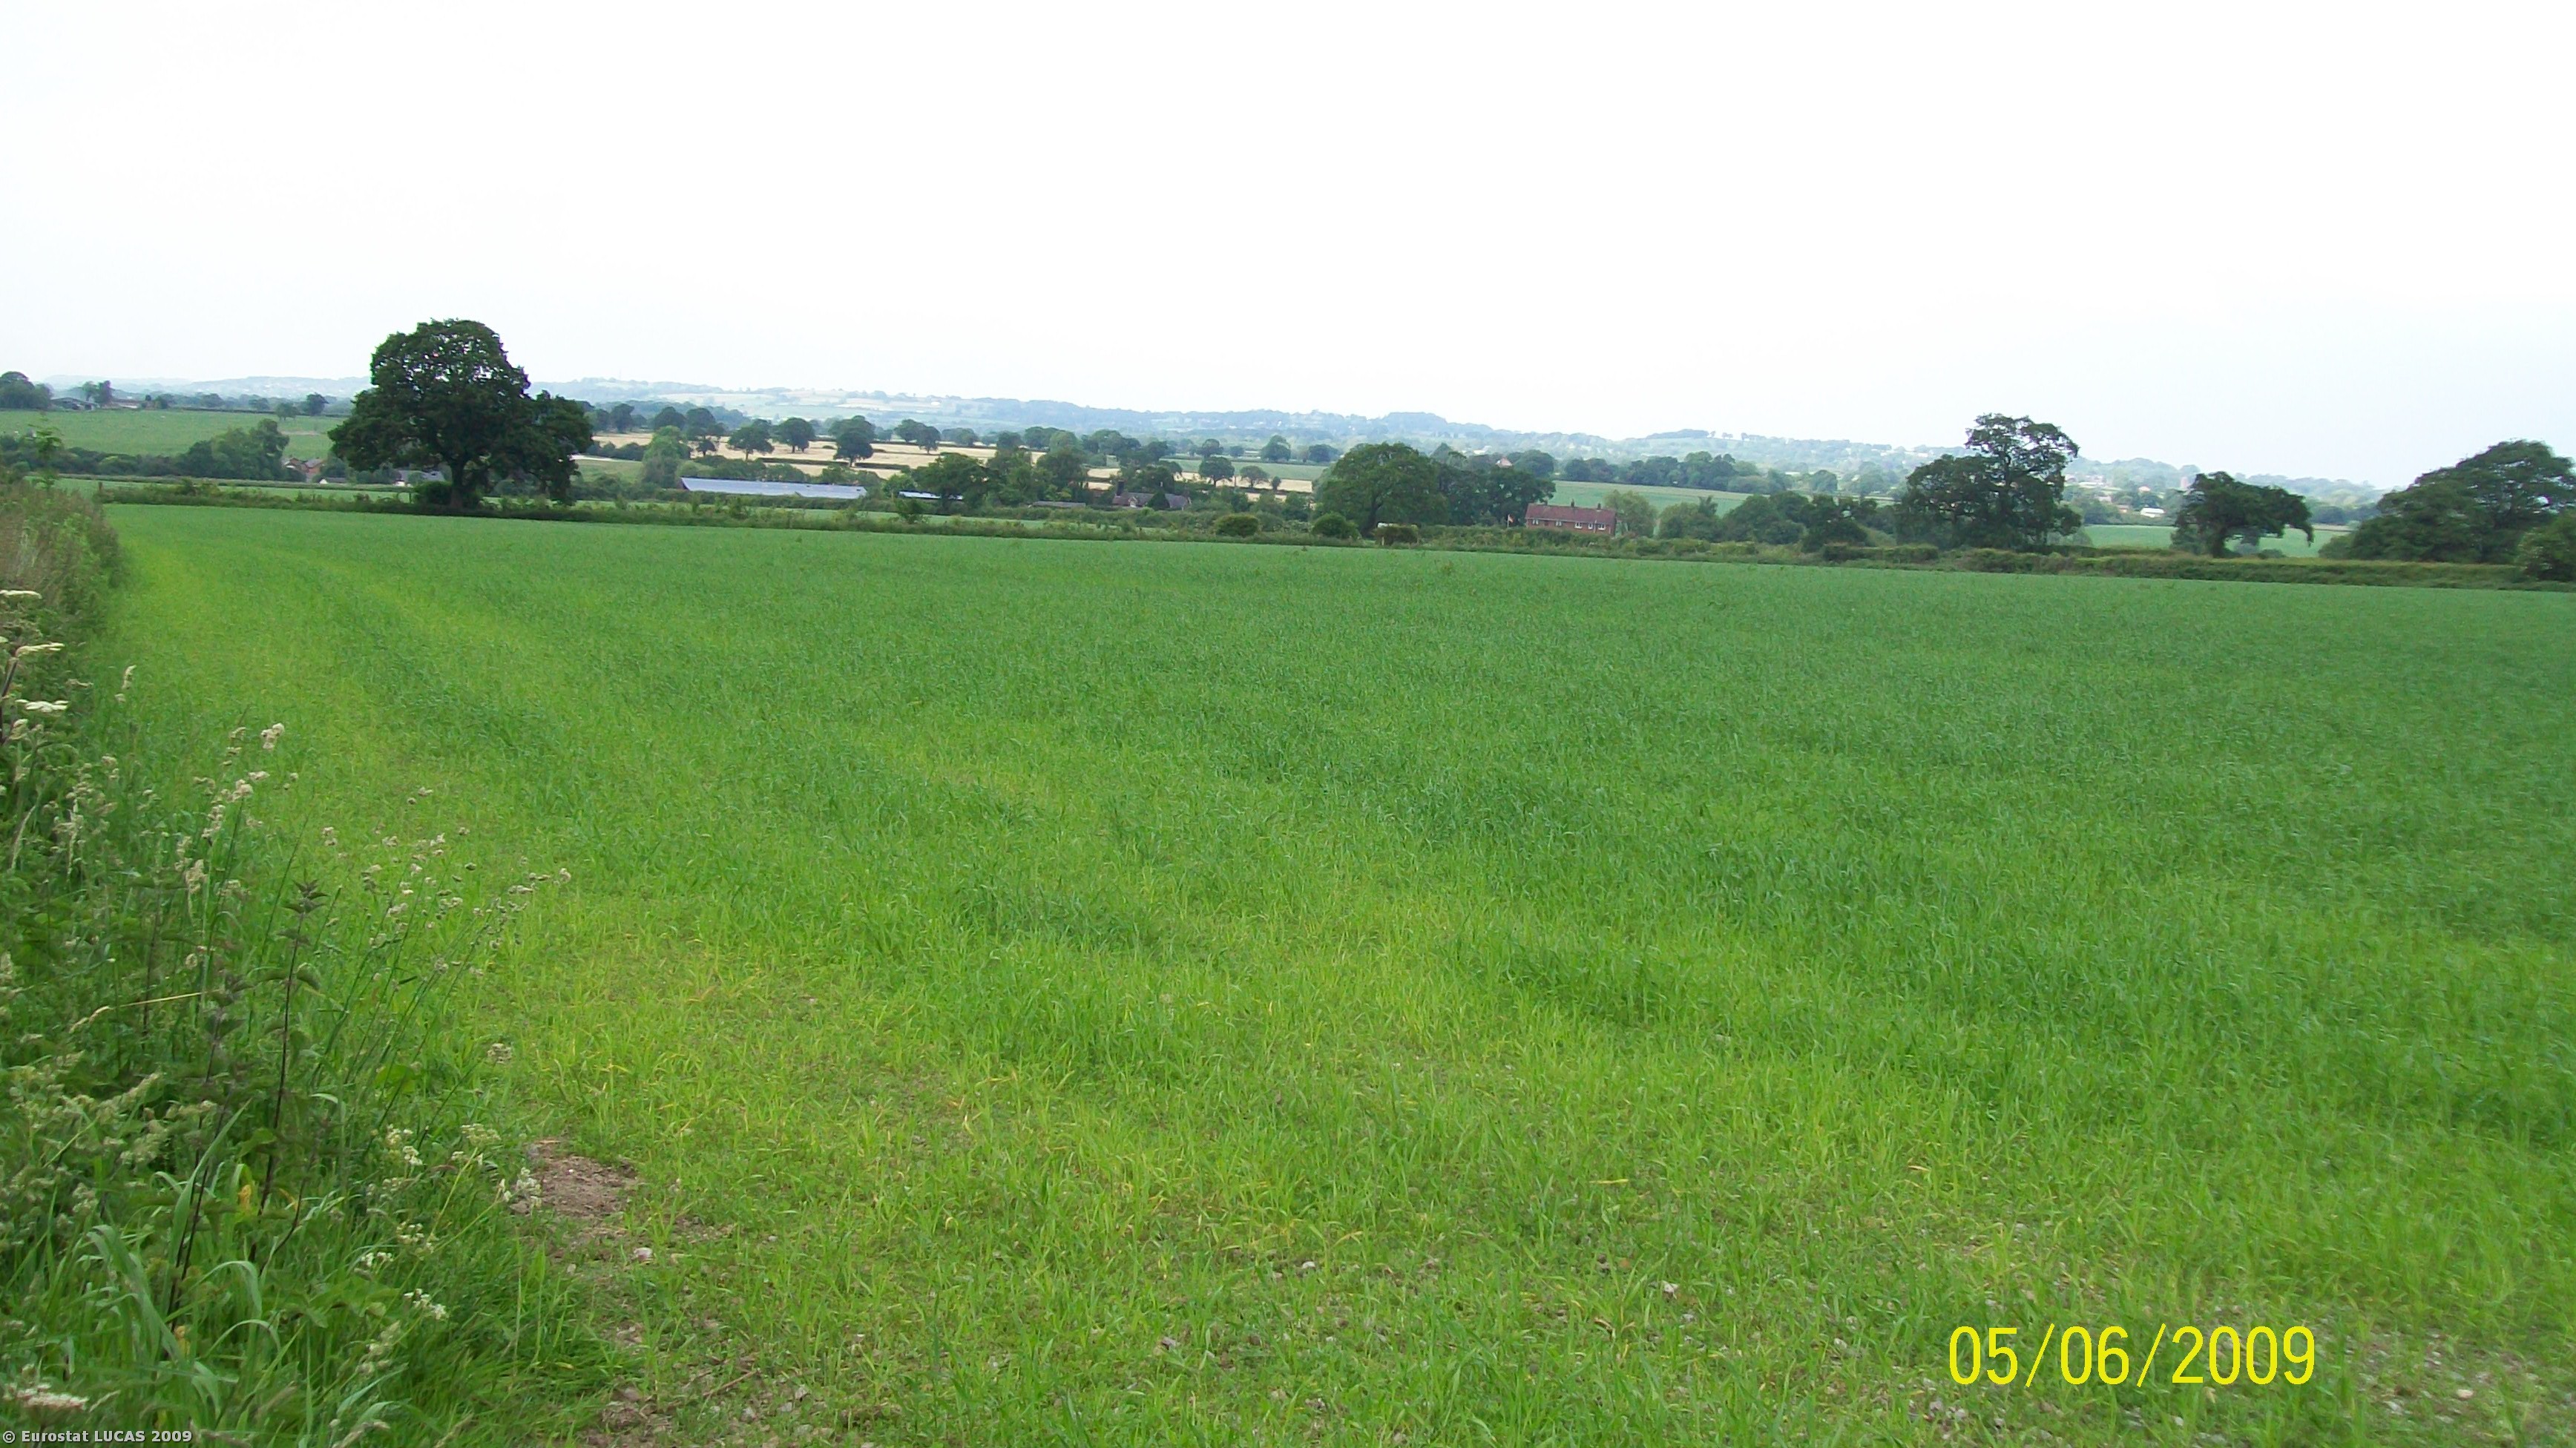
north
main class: Cropland
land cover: Barley
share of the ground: > 75 %
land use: Agriculture (excluding fallow land and kitchen gardens)
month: June
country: GB
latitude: 53.1306
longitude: -2.6984
